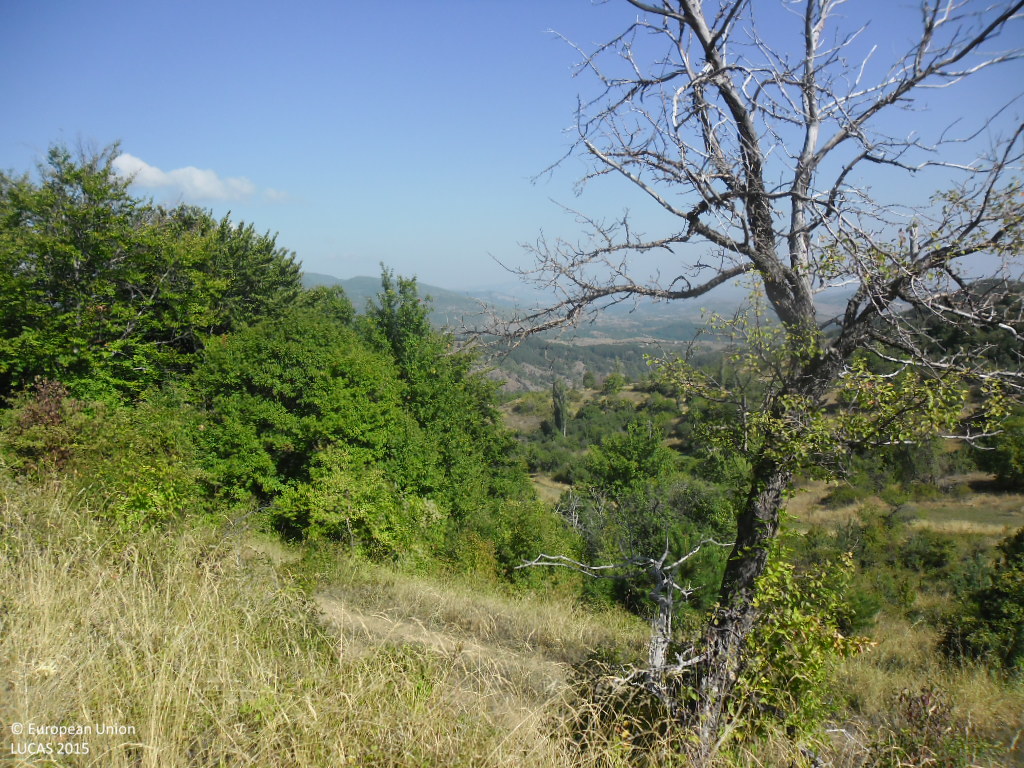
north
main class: Grassland
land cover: Grassland with sparse tree/shrub cover
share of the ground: > 75 %
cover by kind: herbaceous plants 90 %, broadleaved forest trees 5 %, shrubs 5 %
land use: Agriculture (excluding fallow land and kitchen gardens)
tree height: < 5 m
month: September
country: BG
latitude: 41.8737
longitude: 22.9494
